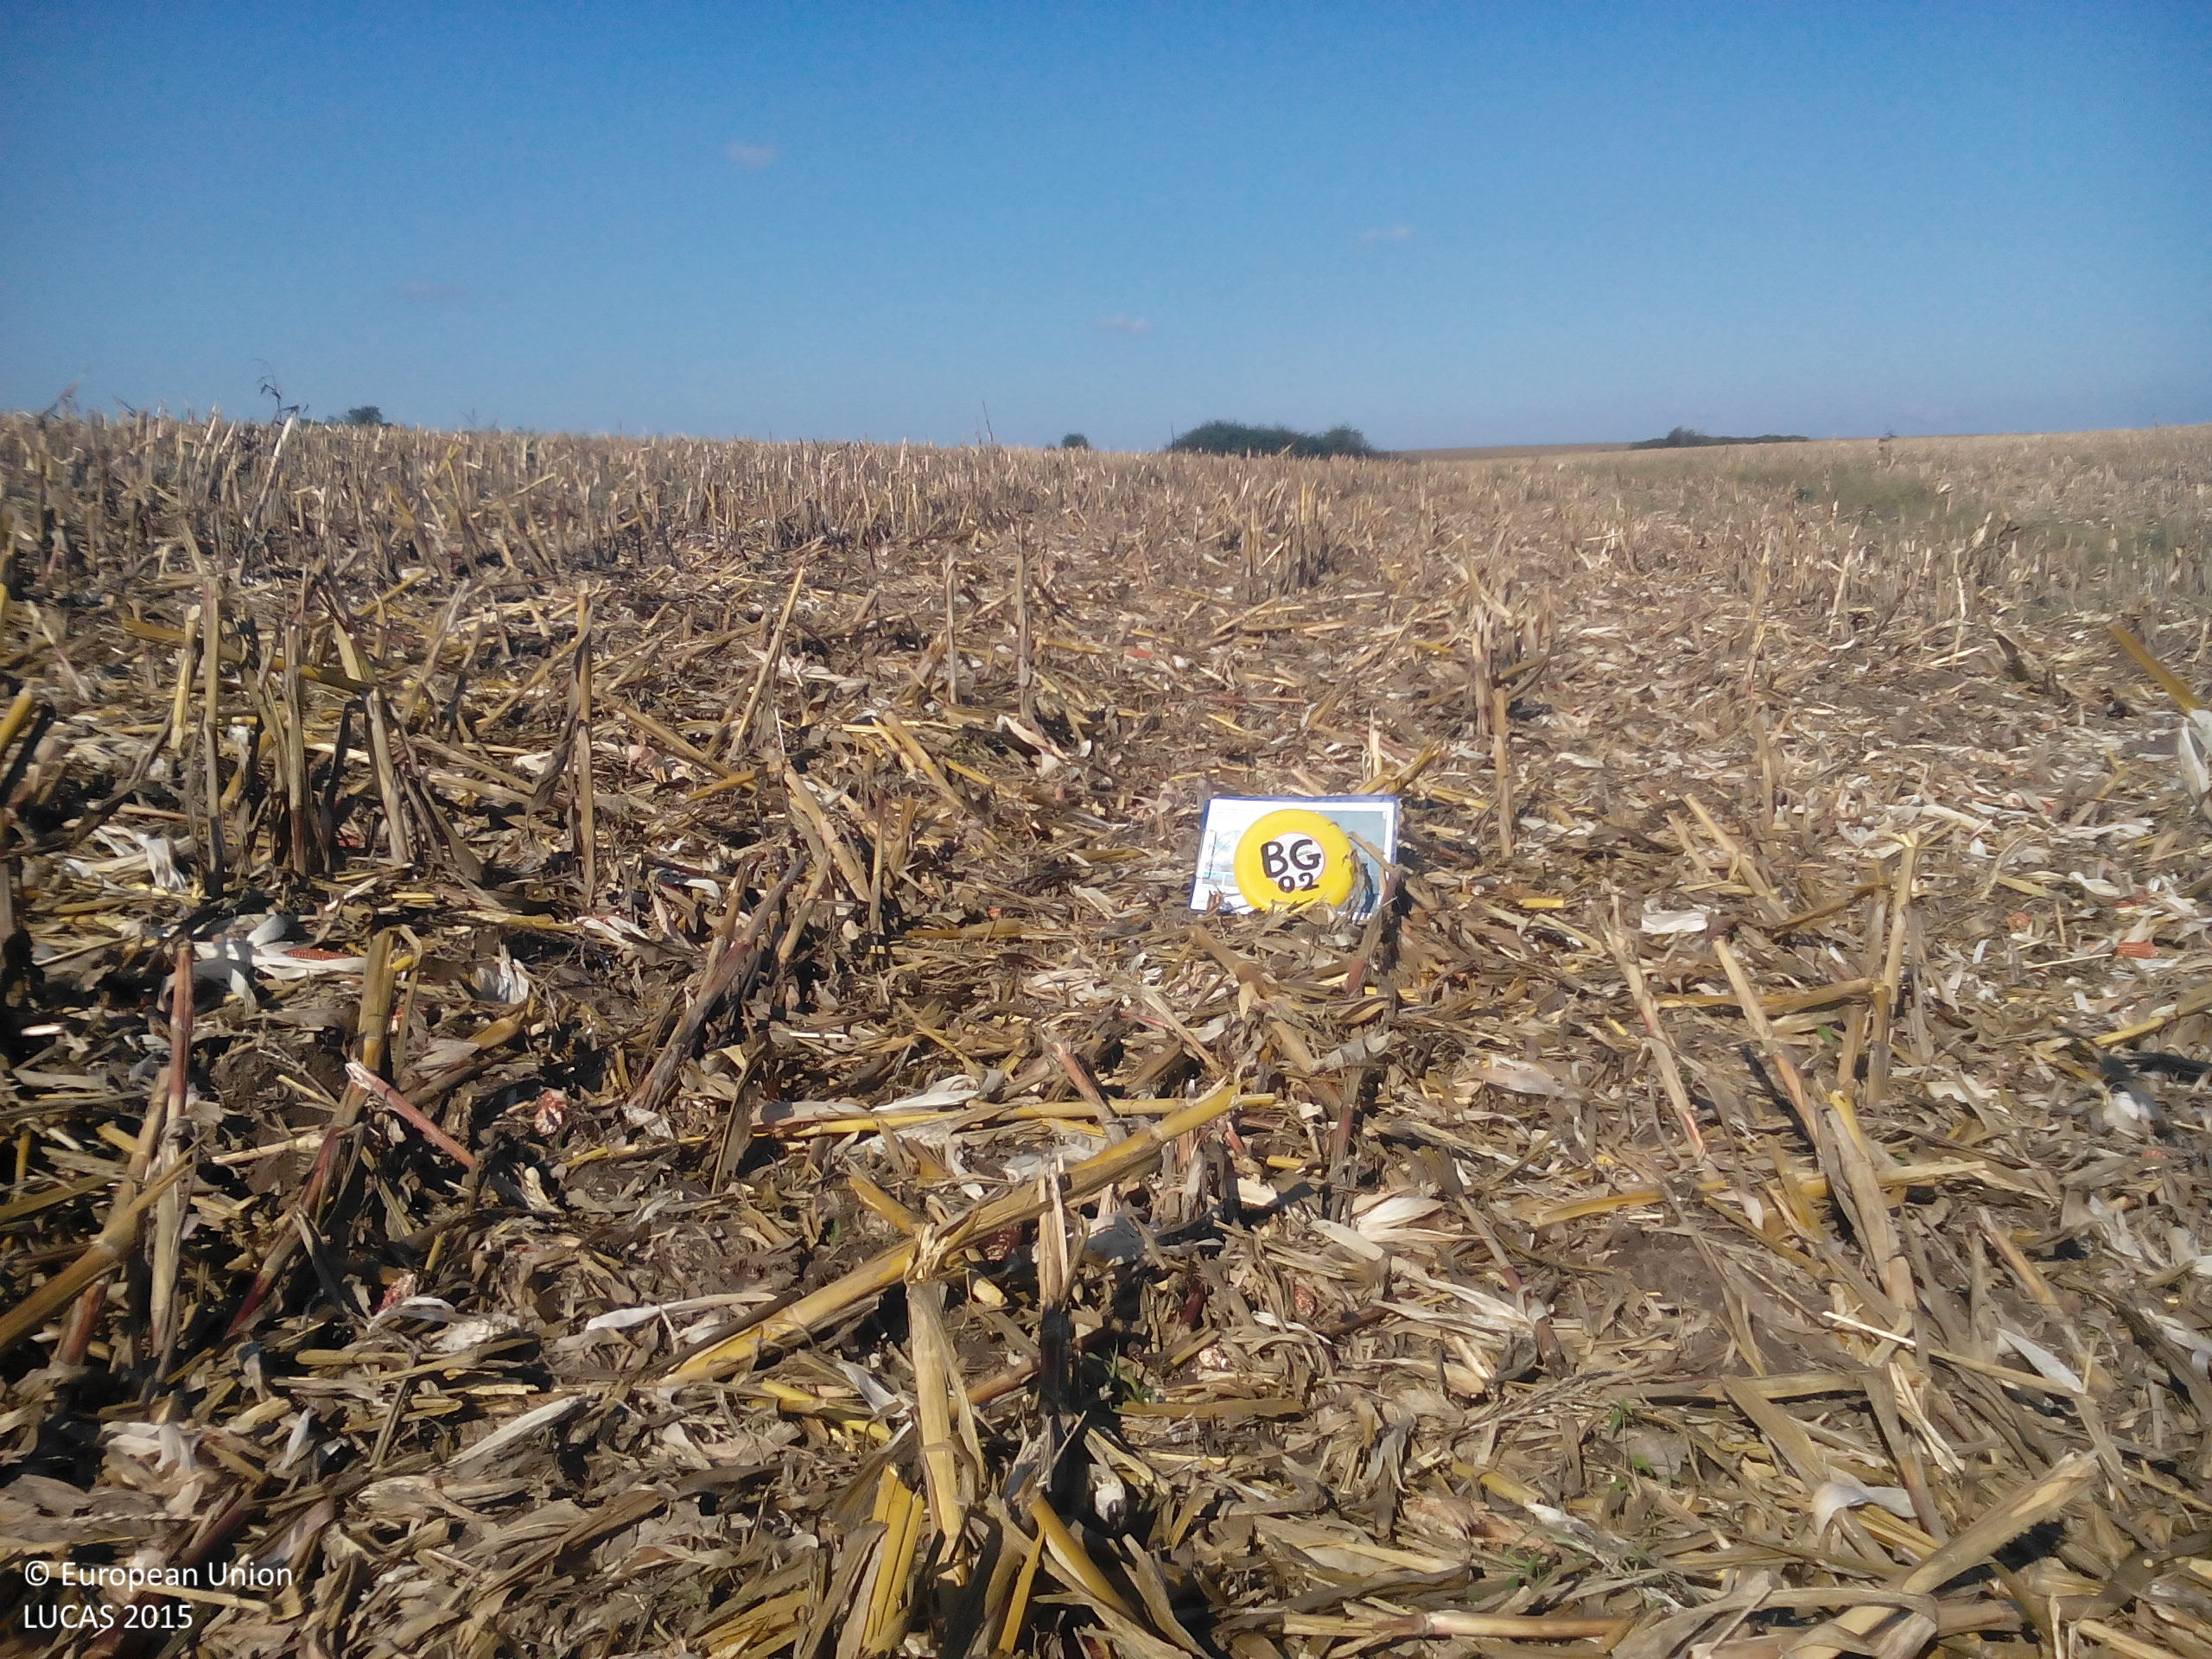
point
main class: Cropland
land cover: Maize
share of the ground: 10 - 25 %
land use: Agriculture (excluding fallow land and kitchen gardens)
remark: Harvested field
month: October
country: BG
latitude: 43.3918
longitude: 23.7636
